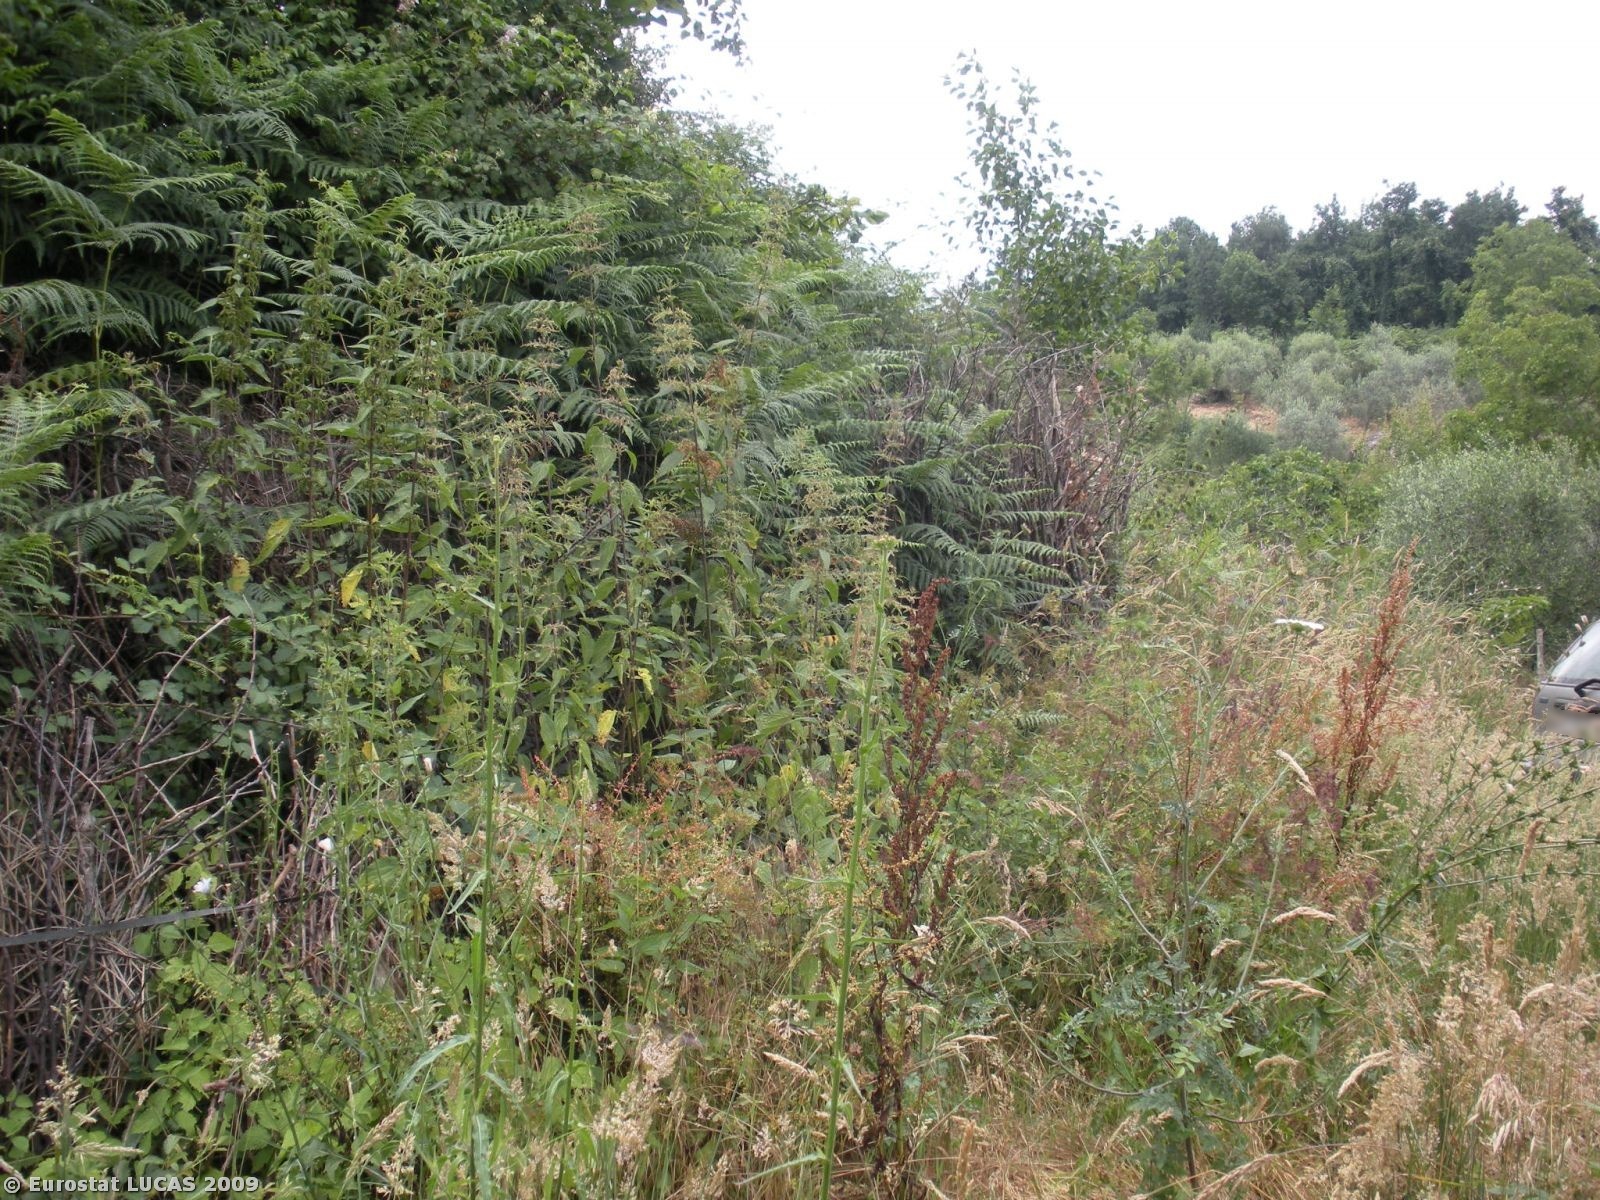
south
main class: Woodland
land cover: Broadleaved woodland
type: thermophilous deciduous forest
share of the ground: > 75 %
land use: Nature reserves
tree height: > 5 m
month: July
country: IT
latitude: 40.2644
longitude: 15.0456
